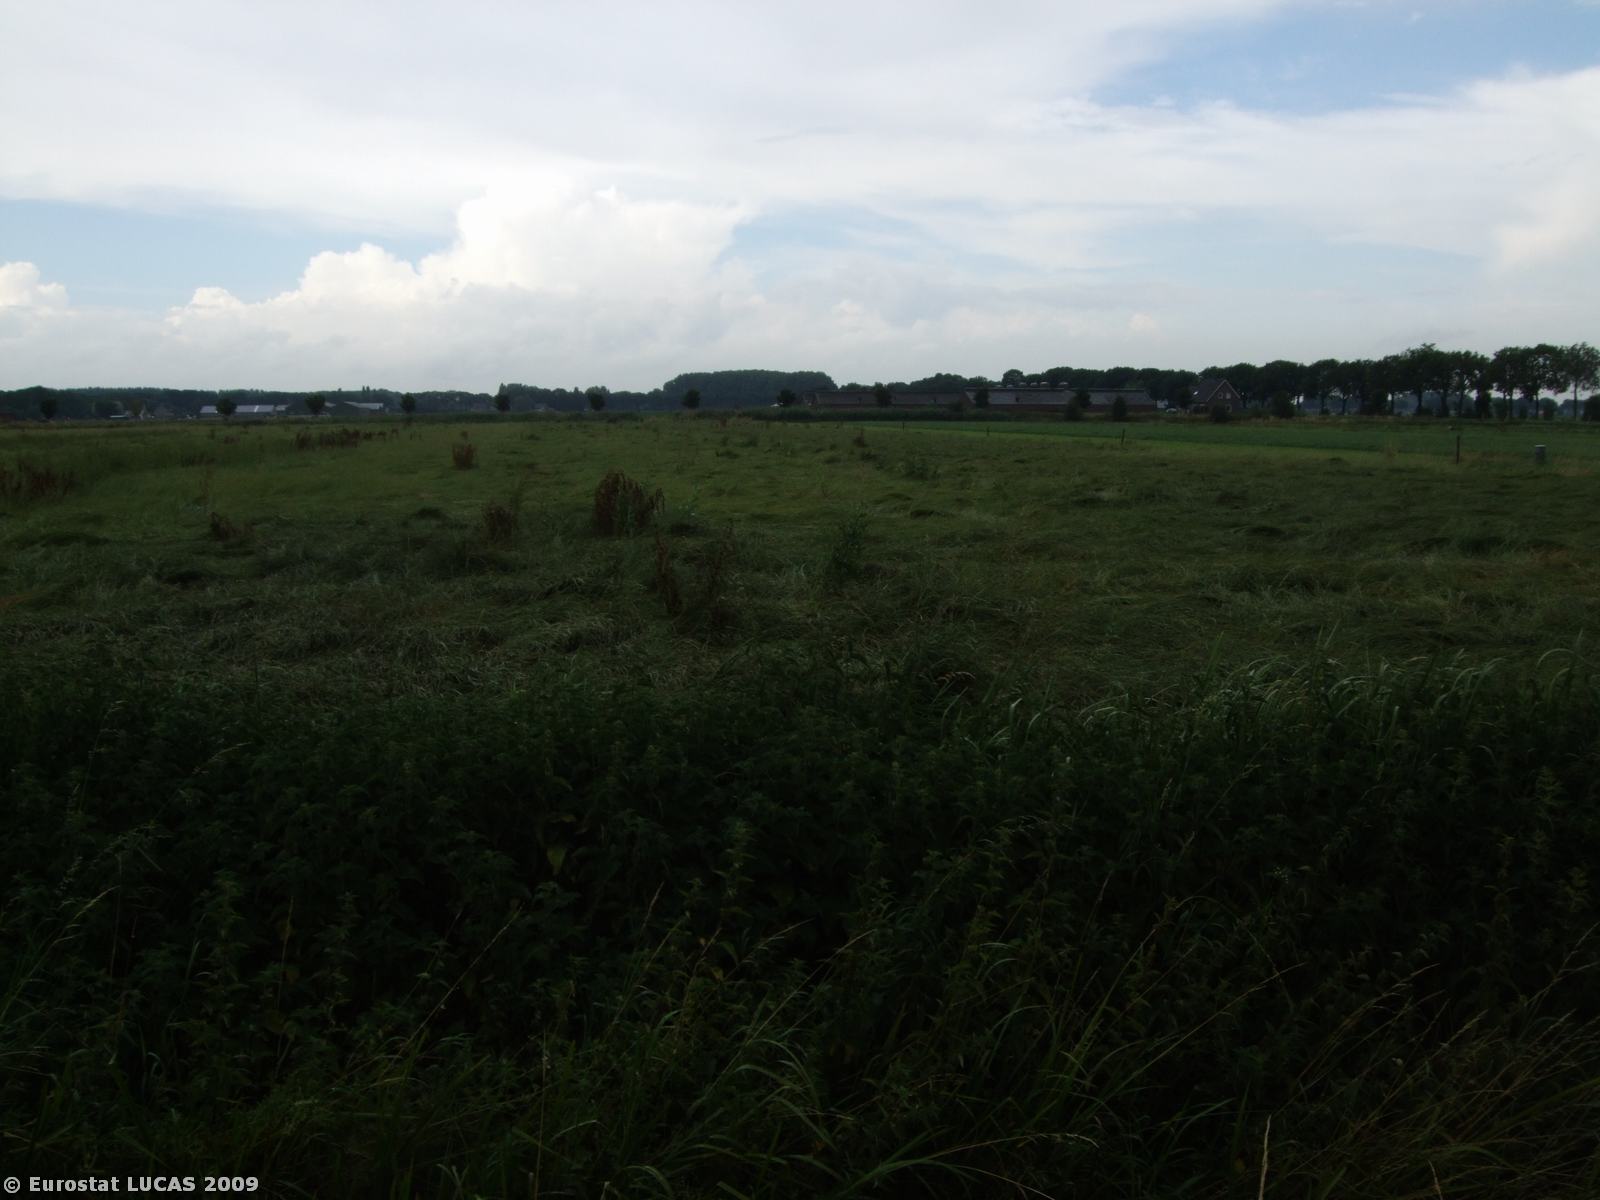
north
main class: Grassland
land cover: Grassland without tree/shrub cover
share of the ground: > 75 %
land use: Agriculture (excluding fallow land and kitchen gardens)
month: July
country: NL
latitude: 51.7844
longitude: 5.4028
